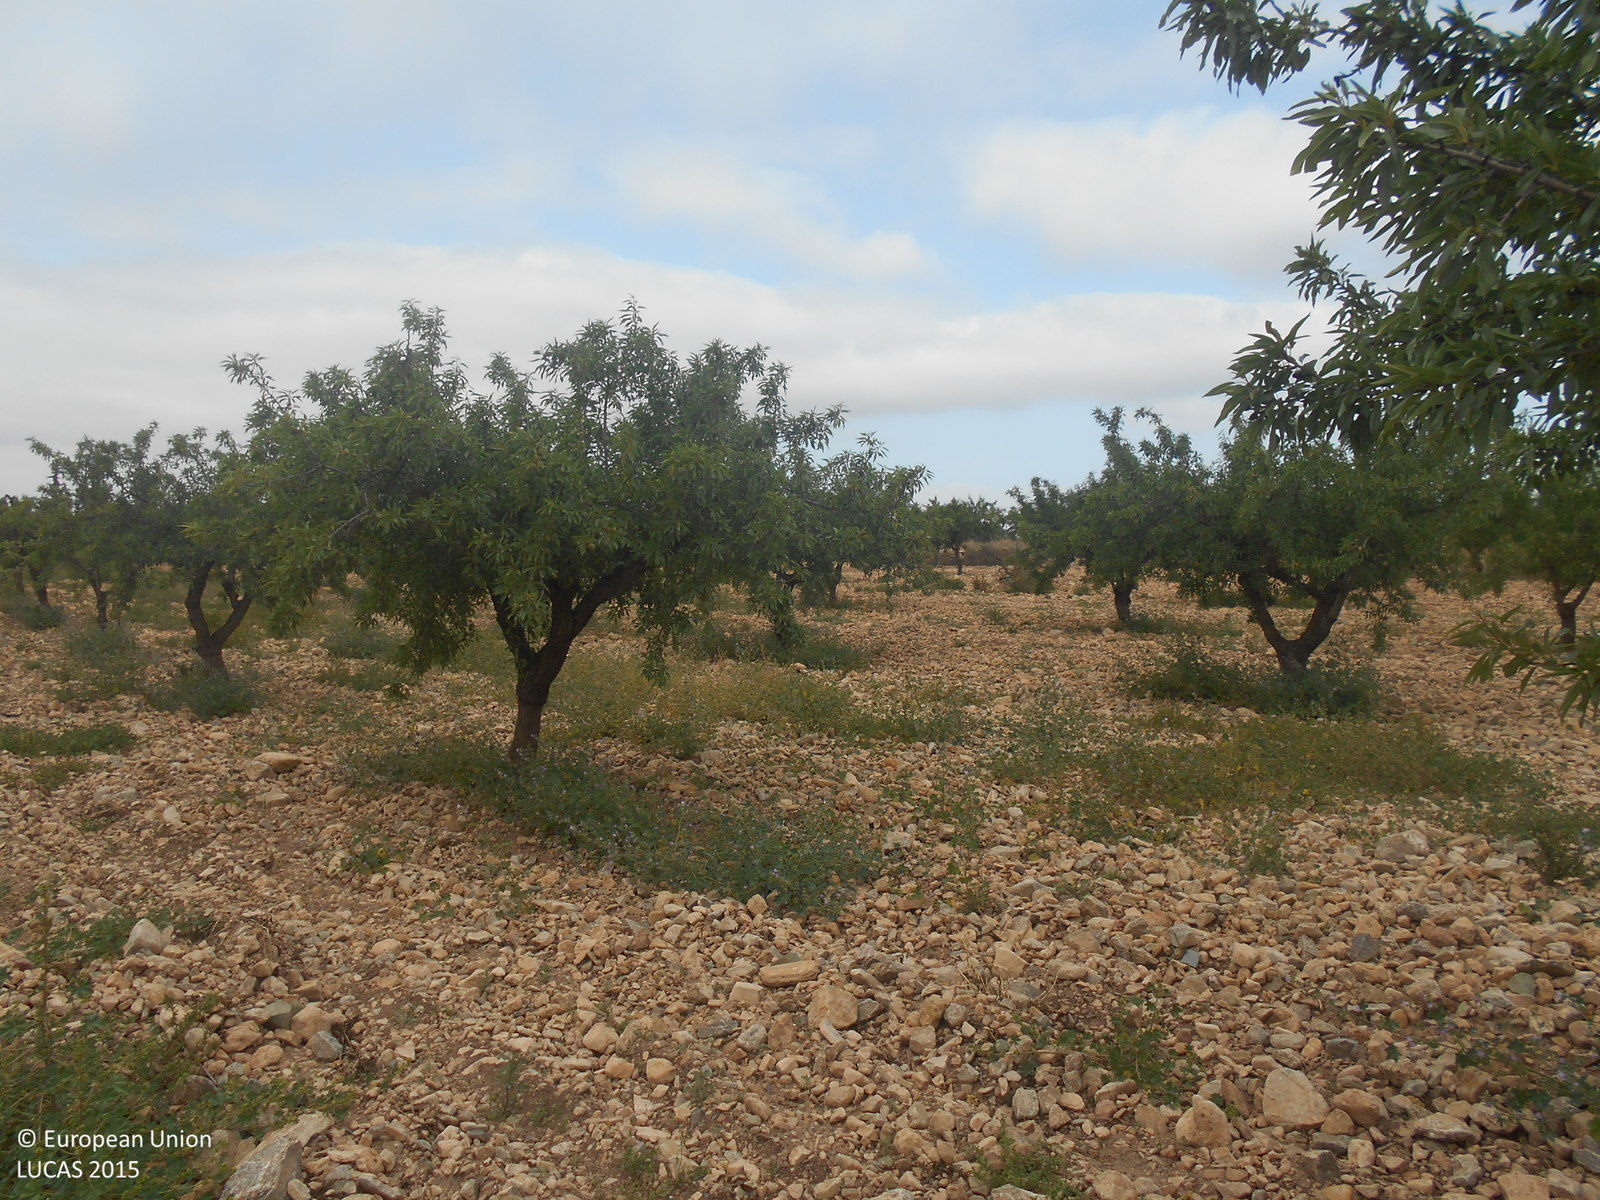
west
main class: Cropland
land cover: Nuts trees
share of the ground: 25 - 50 %
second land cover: Other bare soil
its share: > 75 %
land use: Agriculture (excluding fallow land and kitchen gardens)
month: April
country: ES
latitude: 37.7902
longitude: -1.2581
